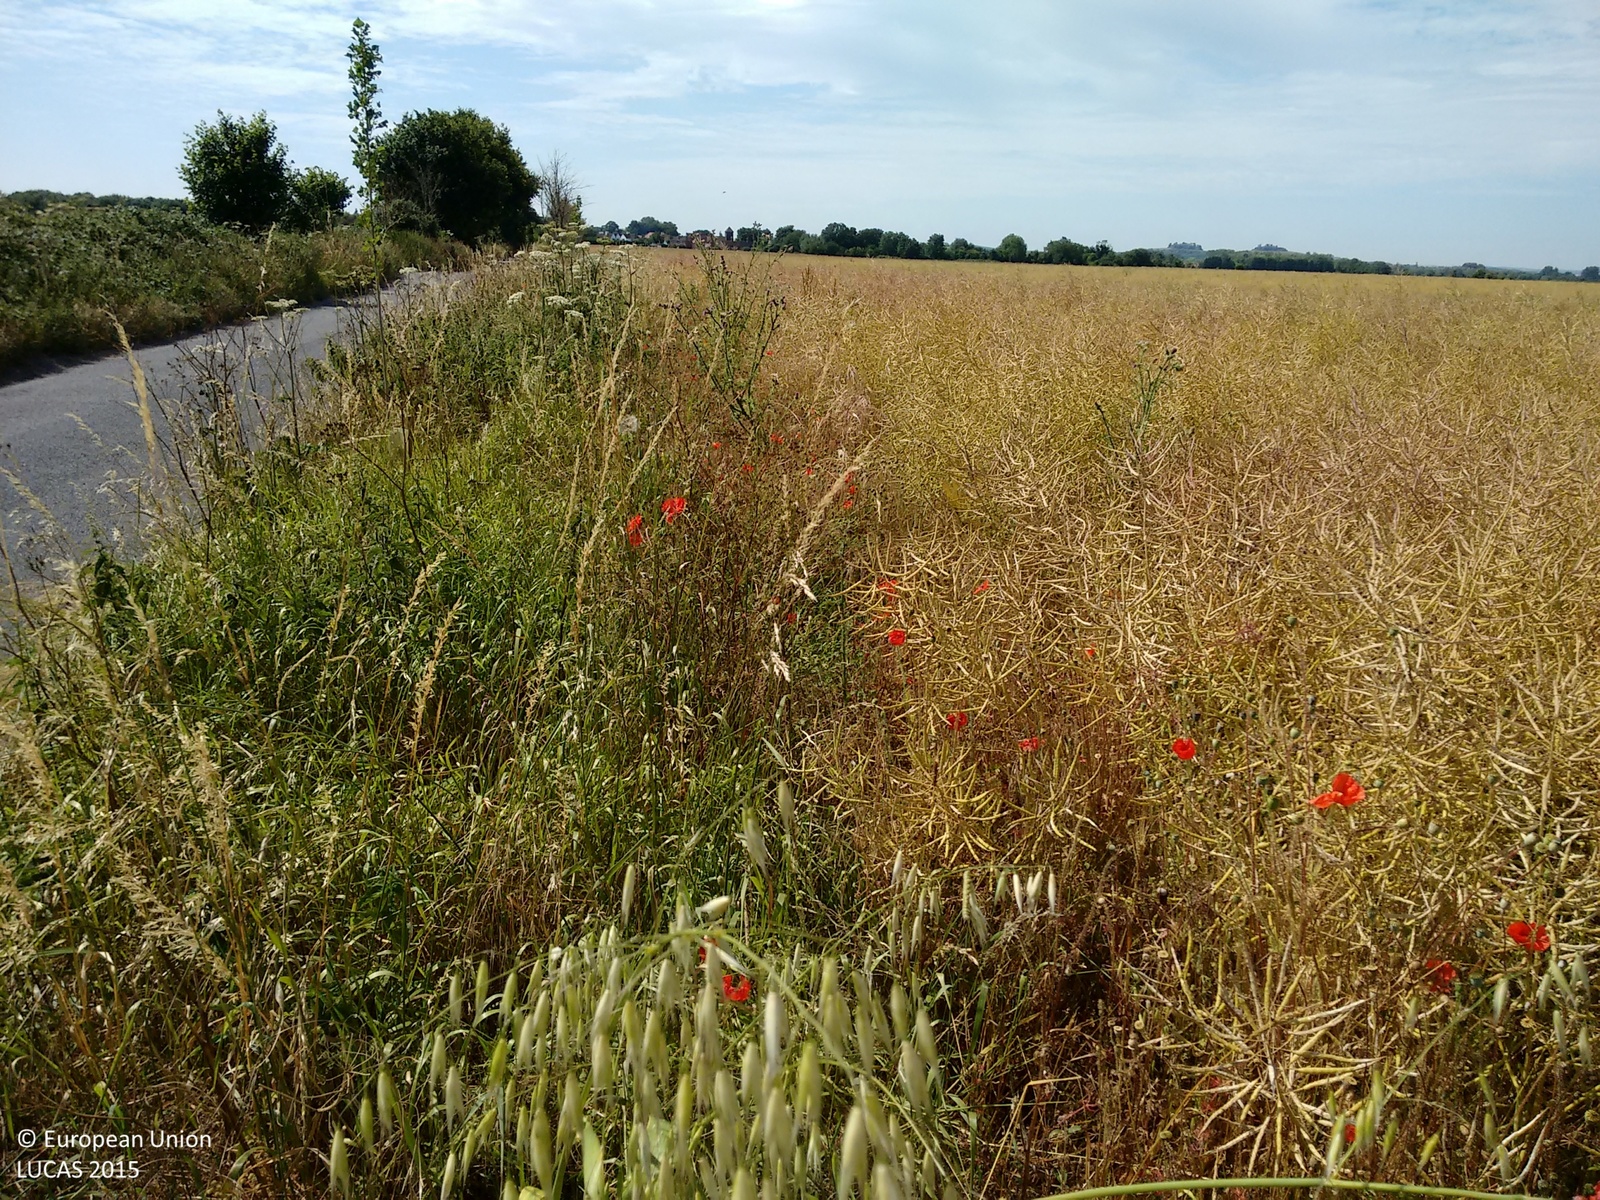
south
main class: Cropland
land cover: Rape and turnip rape
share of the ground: > 75 %
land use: Agriculture (excluding fallow land and kitchen gardens)
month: July
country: GB
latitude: 51.6701
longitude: -1.1367
